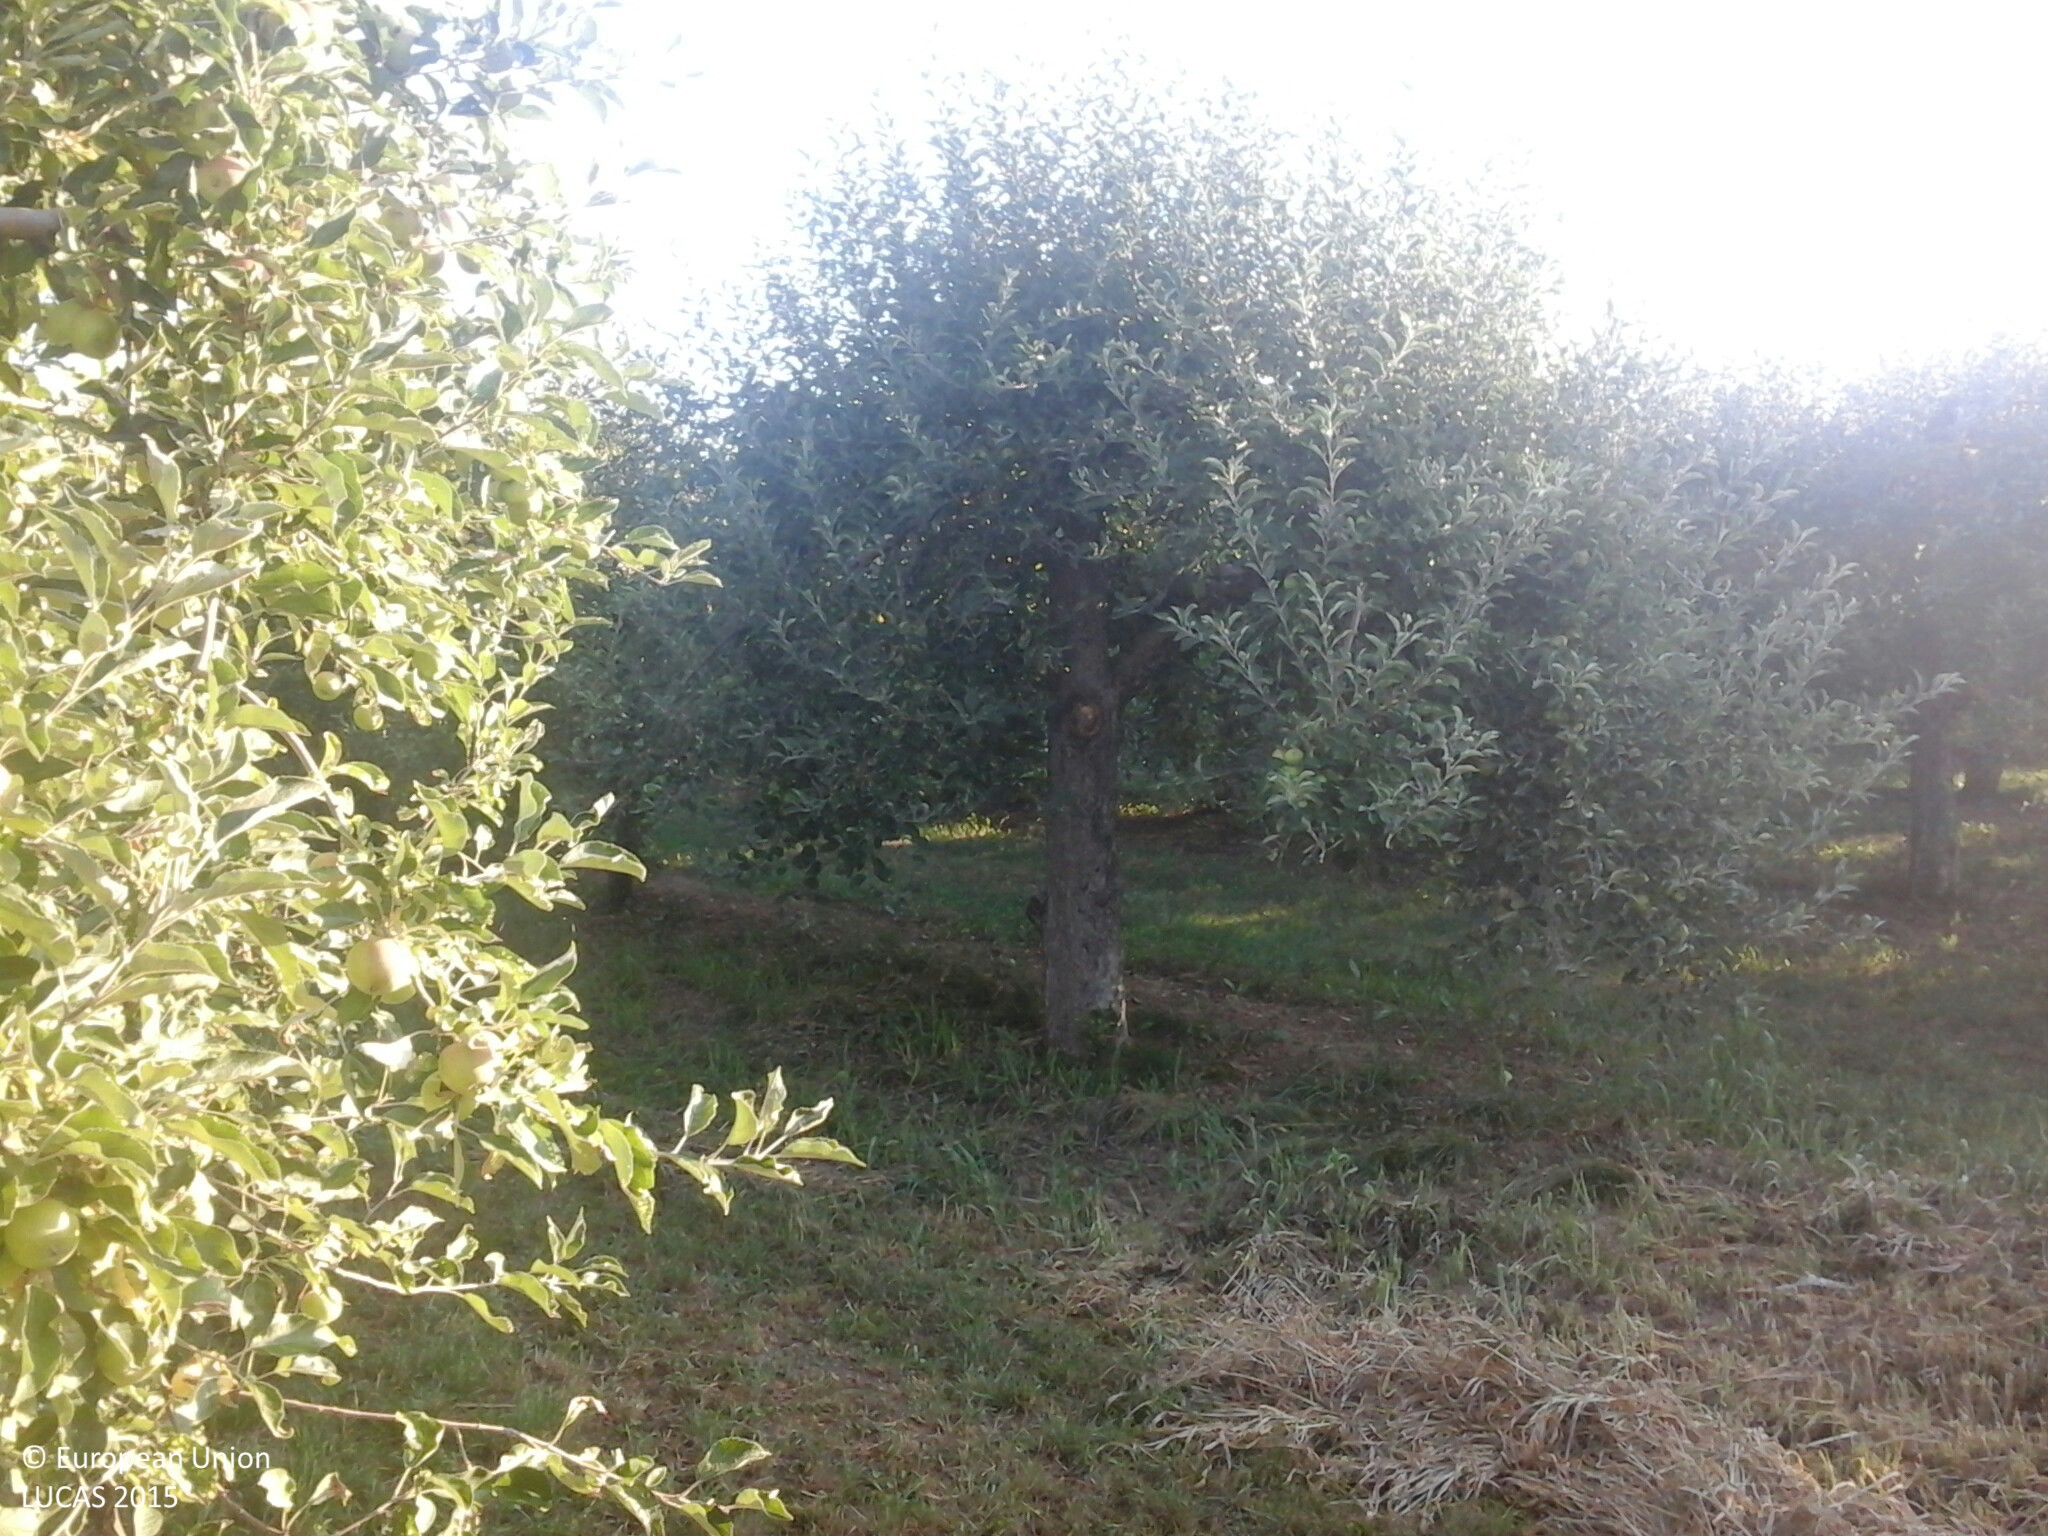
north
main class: Cropland
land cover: Apple fruit
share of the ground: 50 - 75 %
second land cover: Spontaneously vegetated surfaces
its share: 10 - 25 %
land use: Agriculture (excluding fallow land and kitchen gardens)
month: July
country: HU
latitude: 48.1148
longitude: 22.2938
